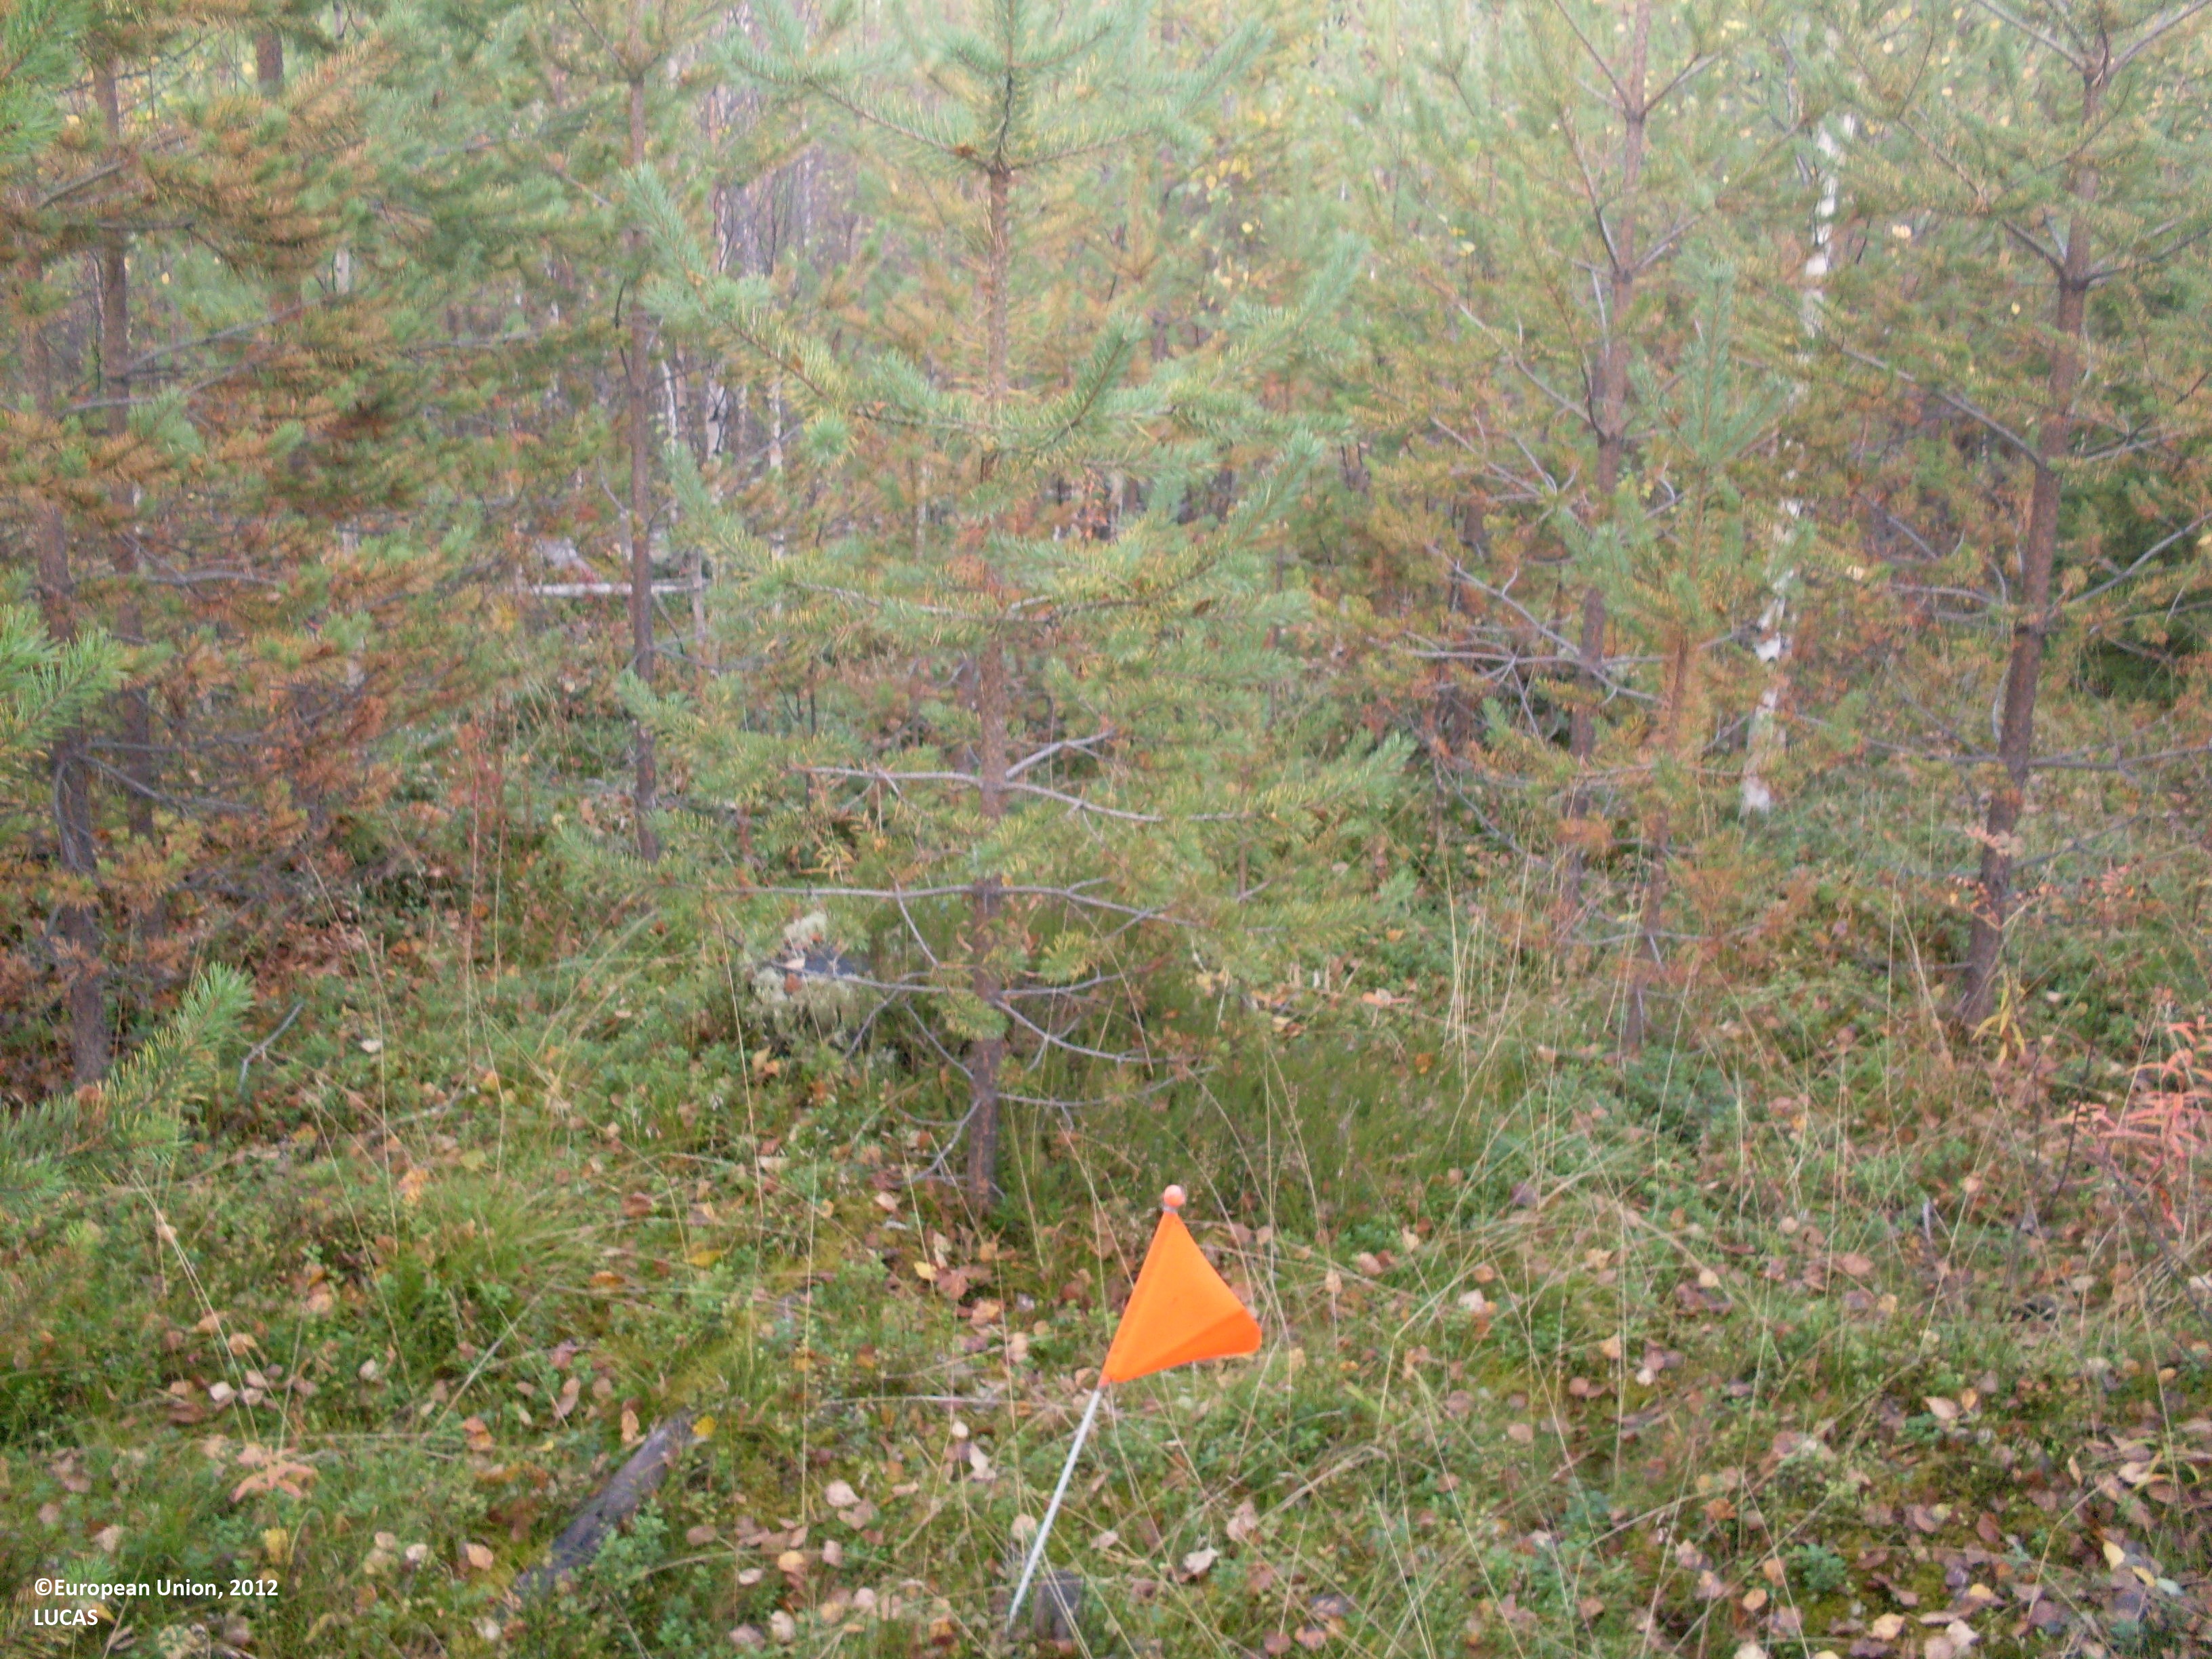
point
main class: Woodland
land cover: Pine dominated coniferous woodland
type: boreal forest
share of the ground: 50 - 75 %
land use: Forestry
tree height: < 5 m
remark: Nursery
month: September
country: FI
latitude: 64.4112
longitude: 28.3716
